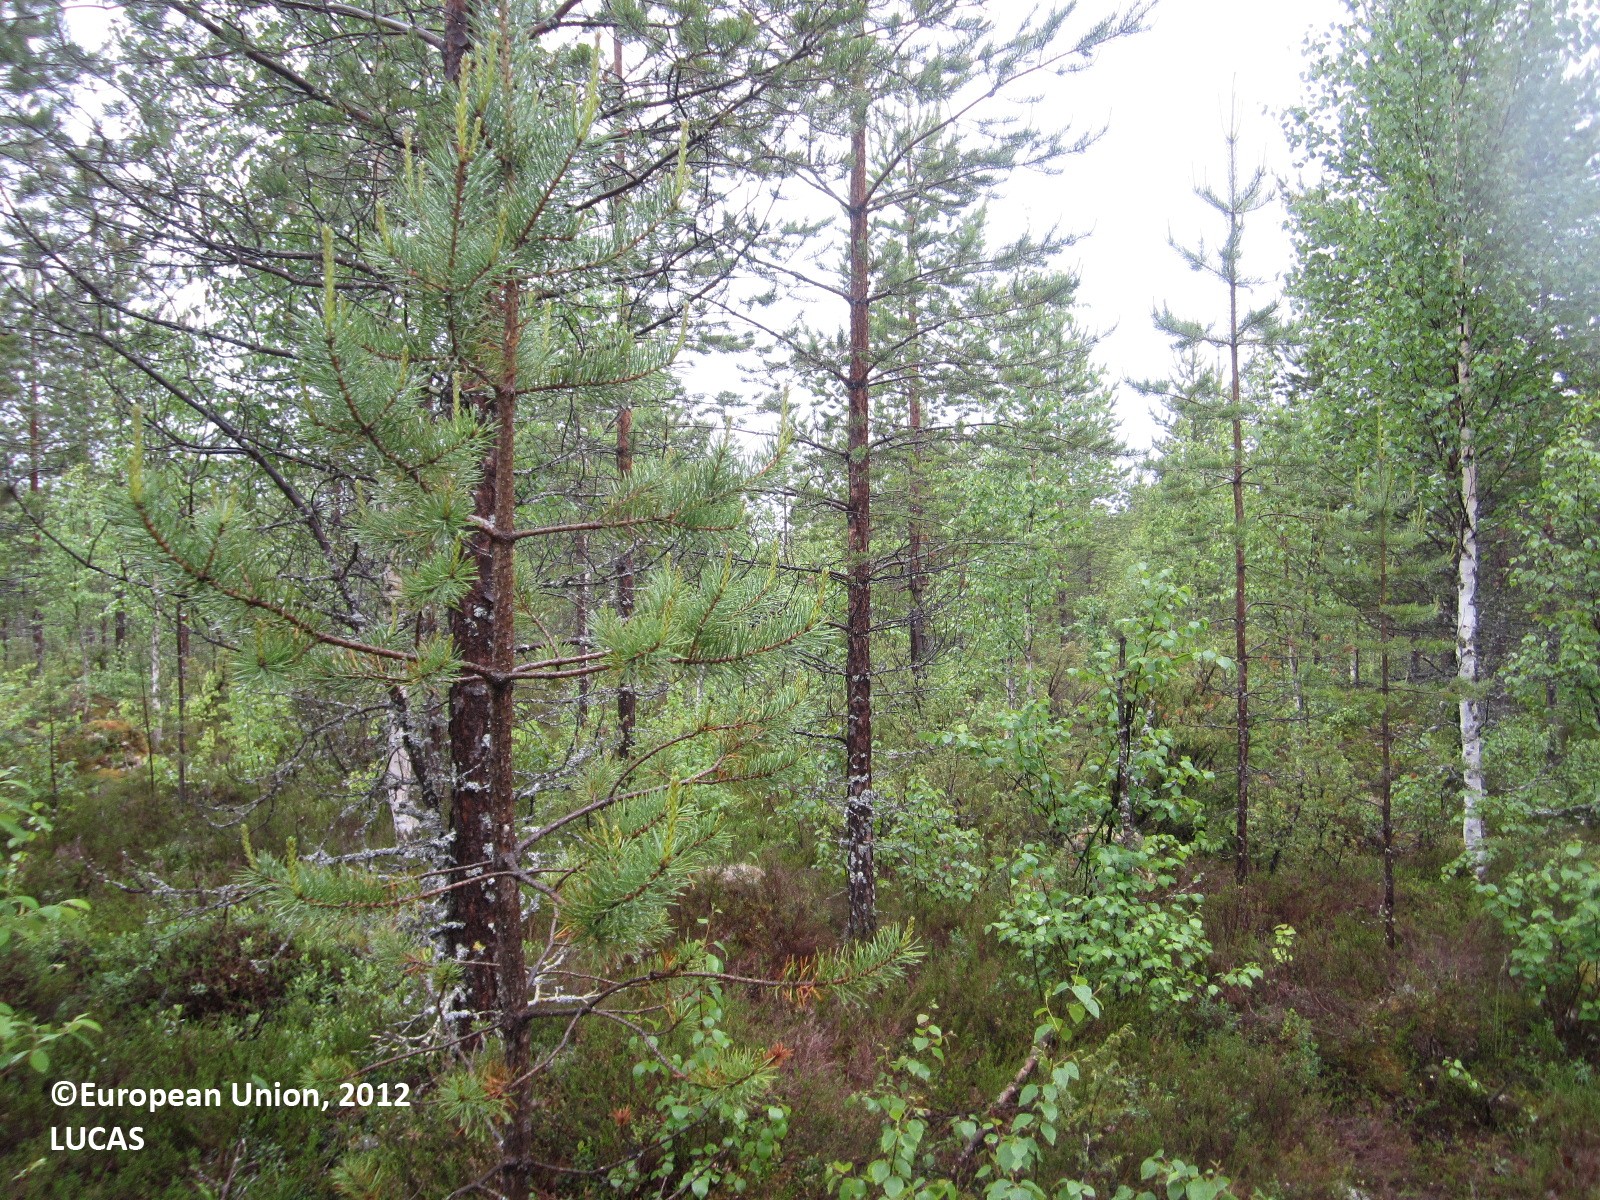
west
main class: Woodland
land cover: Pine dominated coniferous woodland
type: boreal forest
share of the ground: 50 - 75 %
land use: Forestry
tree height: > 5 m
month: June
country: FI
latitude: 64.6626
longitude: 29.2380
